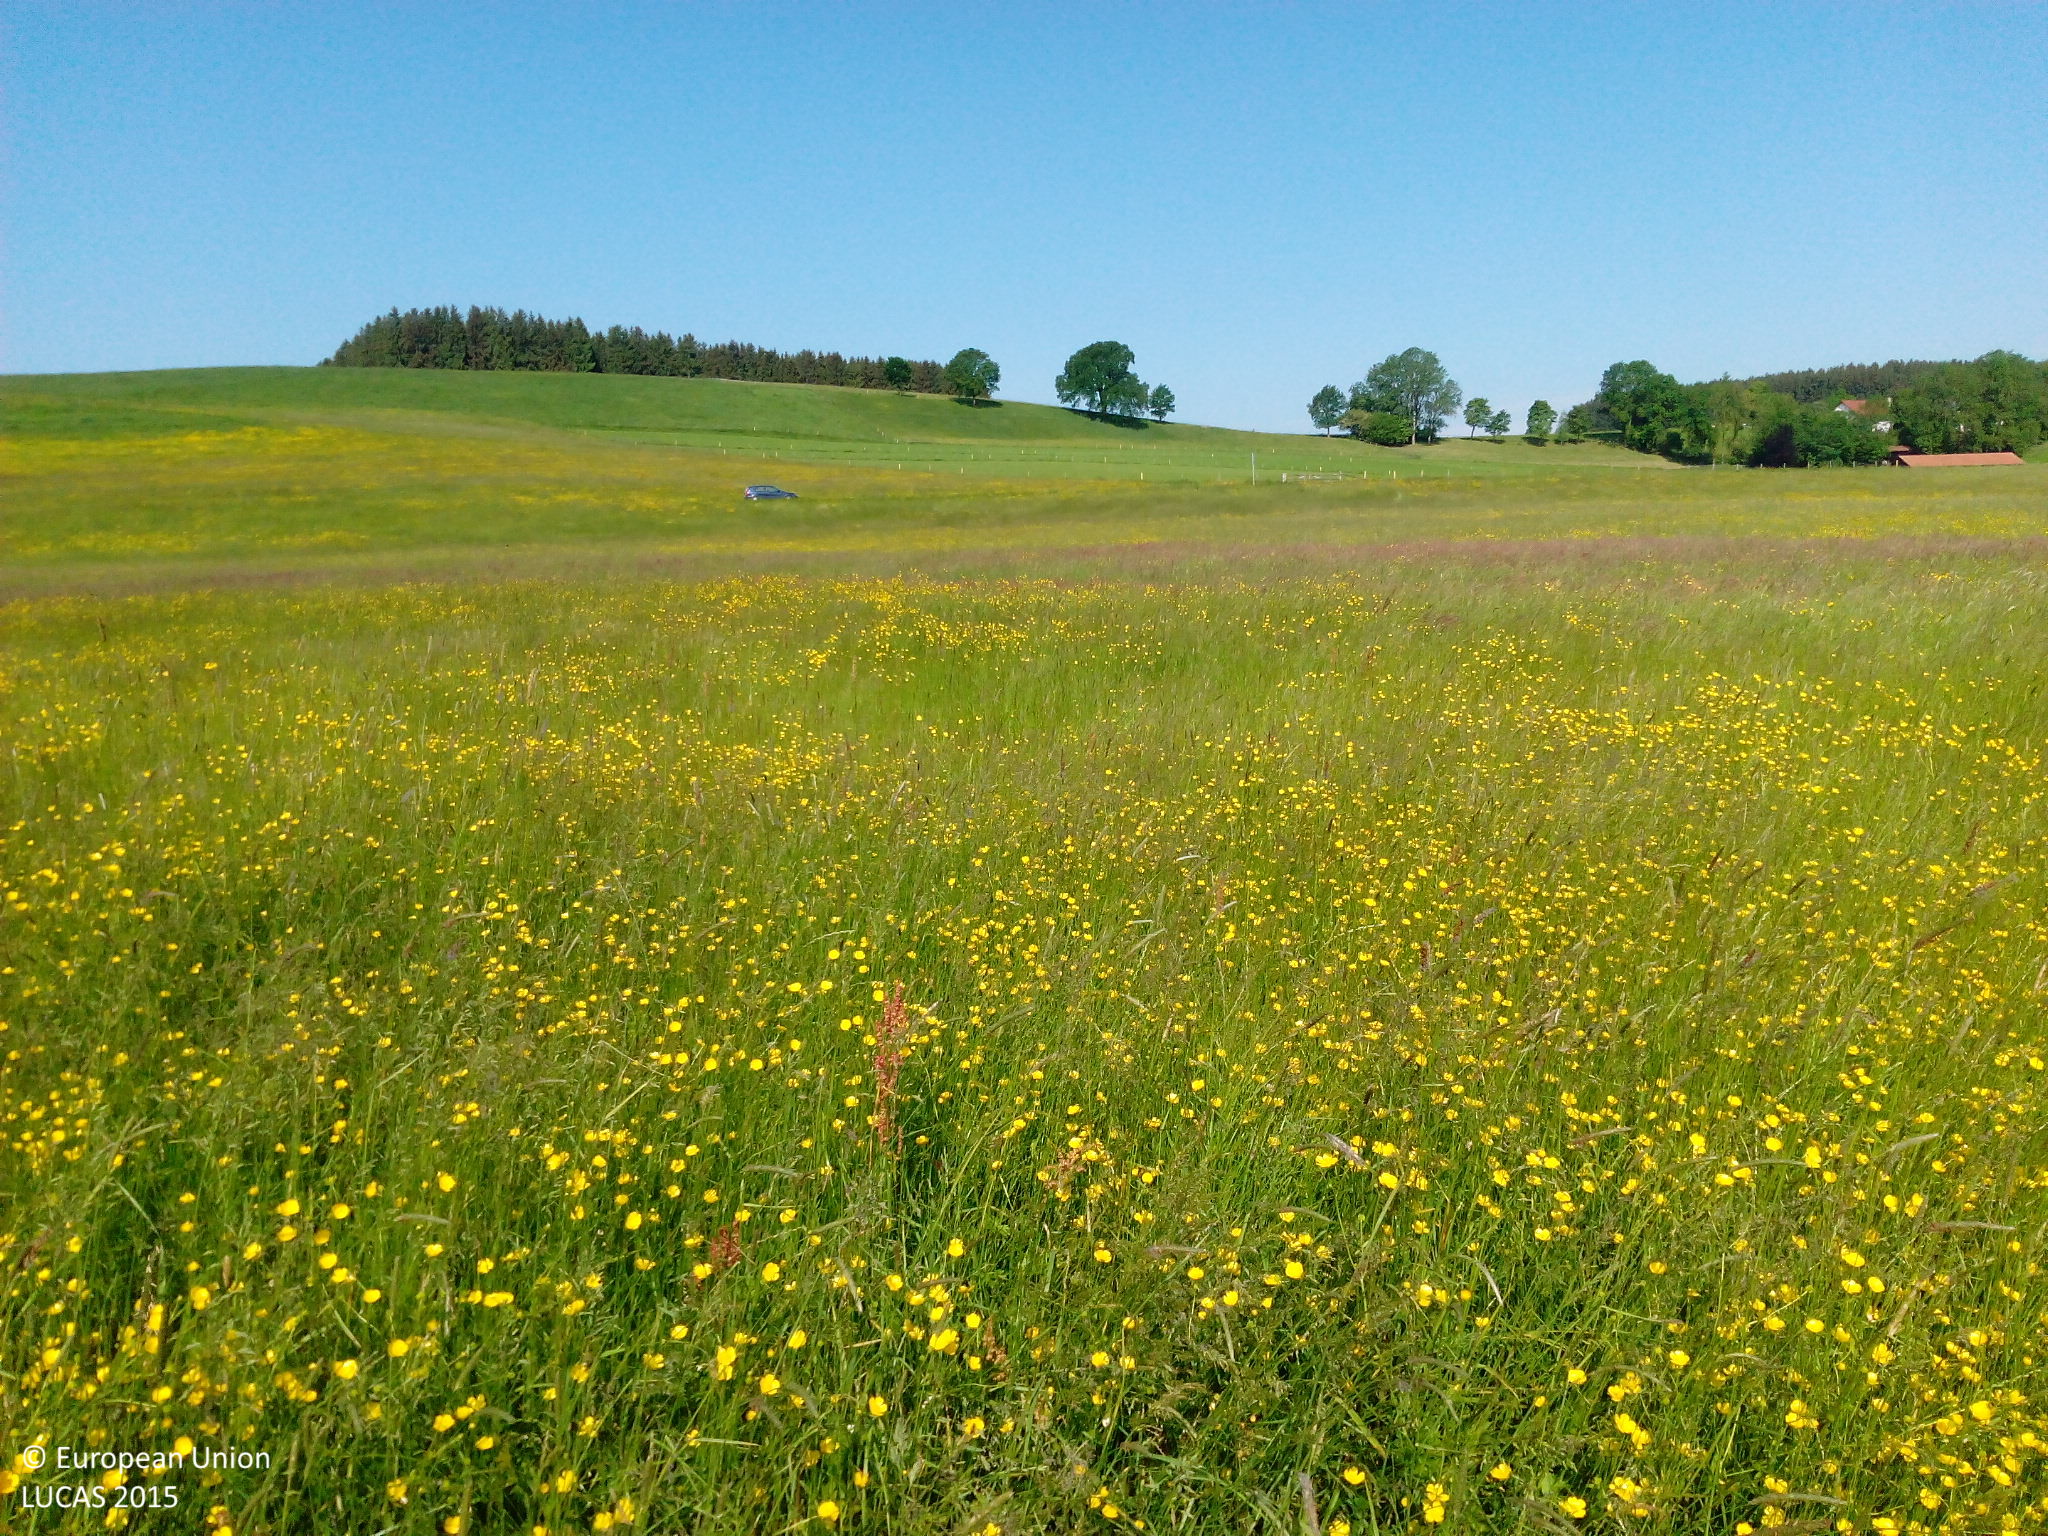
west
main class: Grassland
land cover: Grassland without tree/shrub cover
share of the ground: > 75 %
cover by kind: herbaceous plants 100 %
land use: Agriculture (excluding fallow land and kitchen gardens)
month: June
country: DE
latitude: 47.8453
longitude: 10.2537
